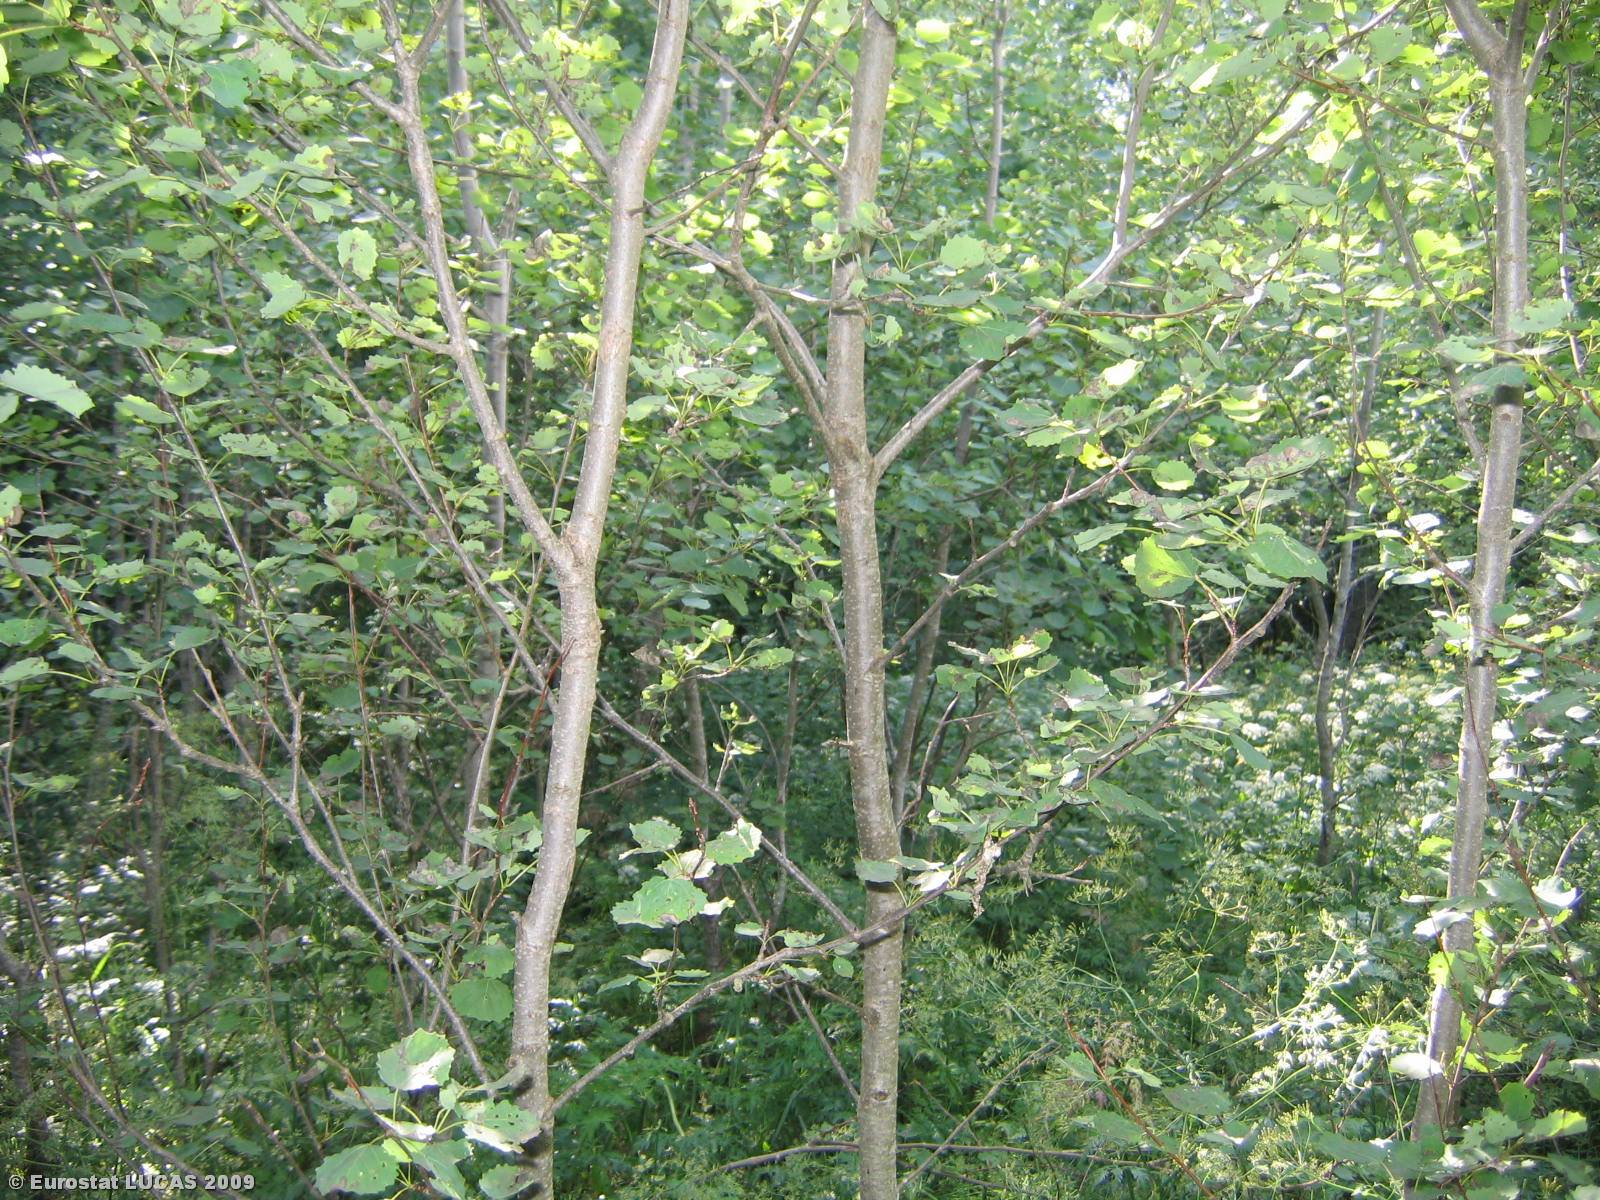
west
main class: Woodland
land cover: Broadleaved woodland
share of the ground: > 75 %
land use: Agriculture (excluding fallow land and kitchen gardens)
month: July
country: LT
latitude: 55.4912
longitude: 22.7749
